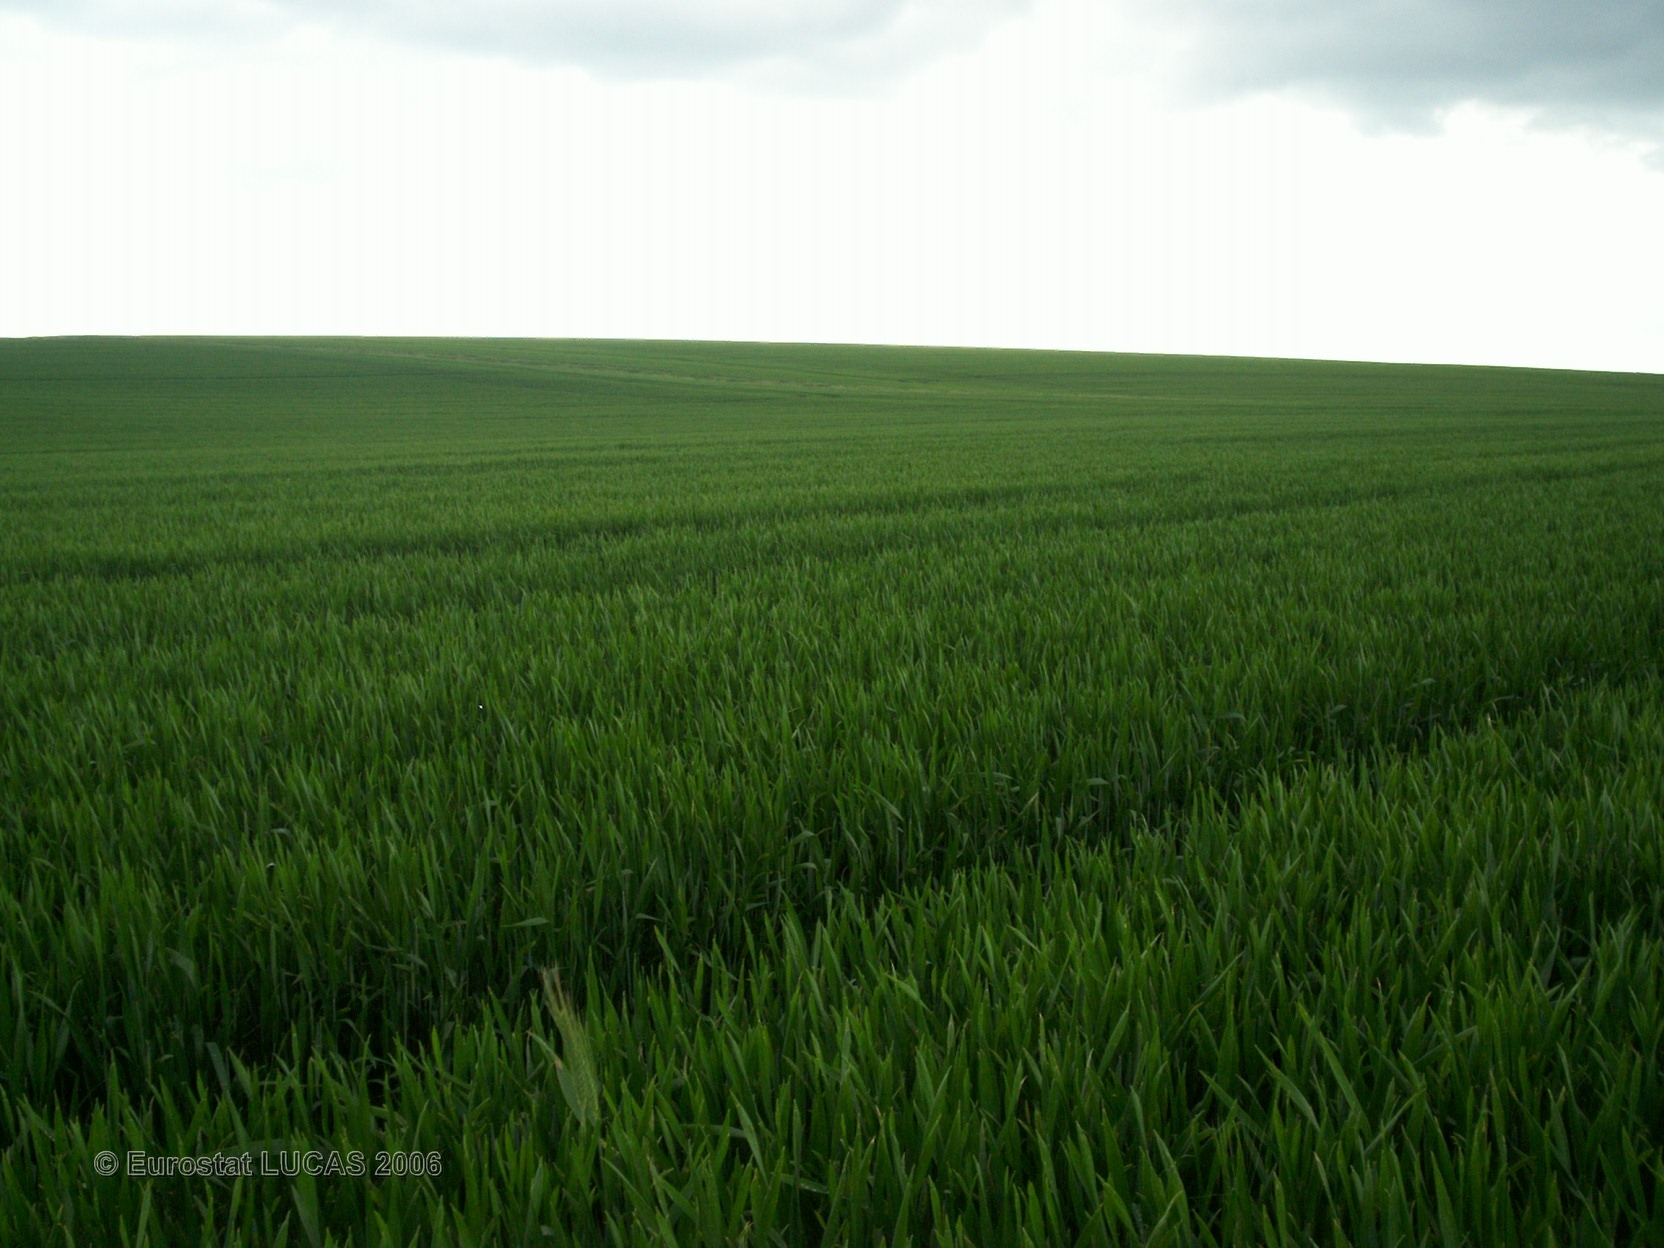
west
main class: Cropland
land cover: Common wheat
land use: Agriculture (excluding fallow land and kitchen gardens)
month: May
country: FR
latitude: 49.2890
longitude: 3.7106
